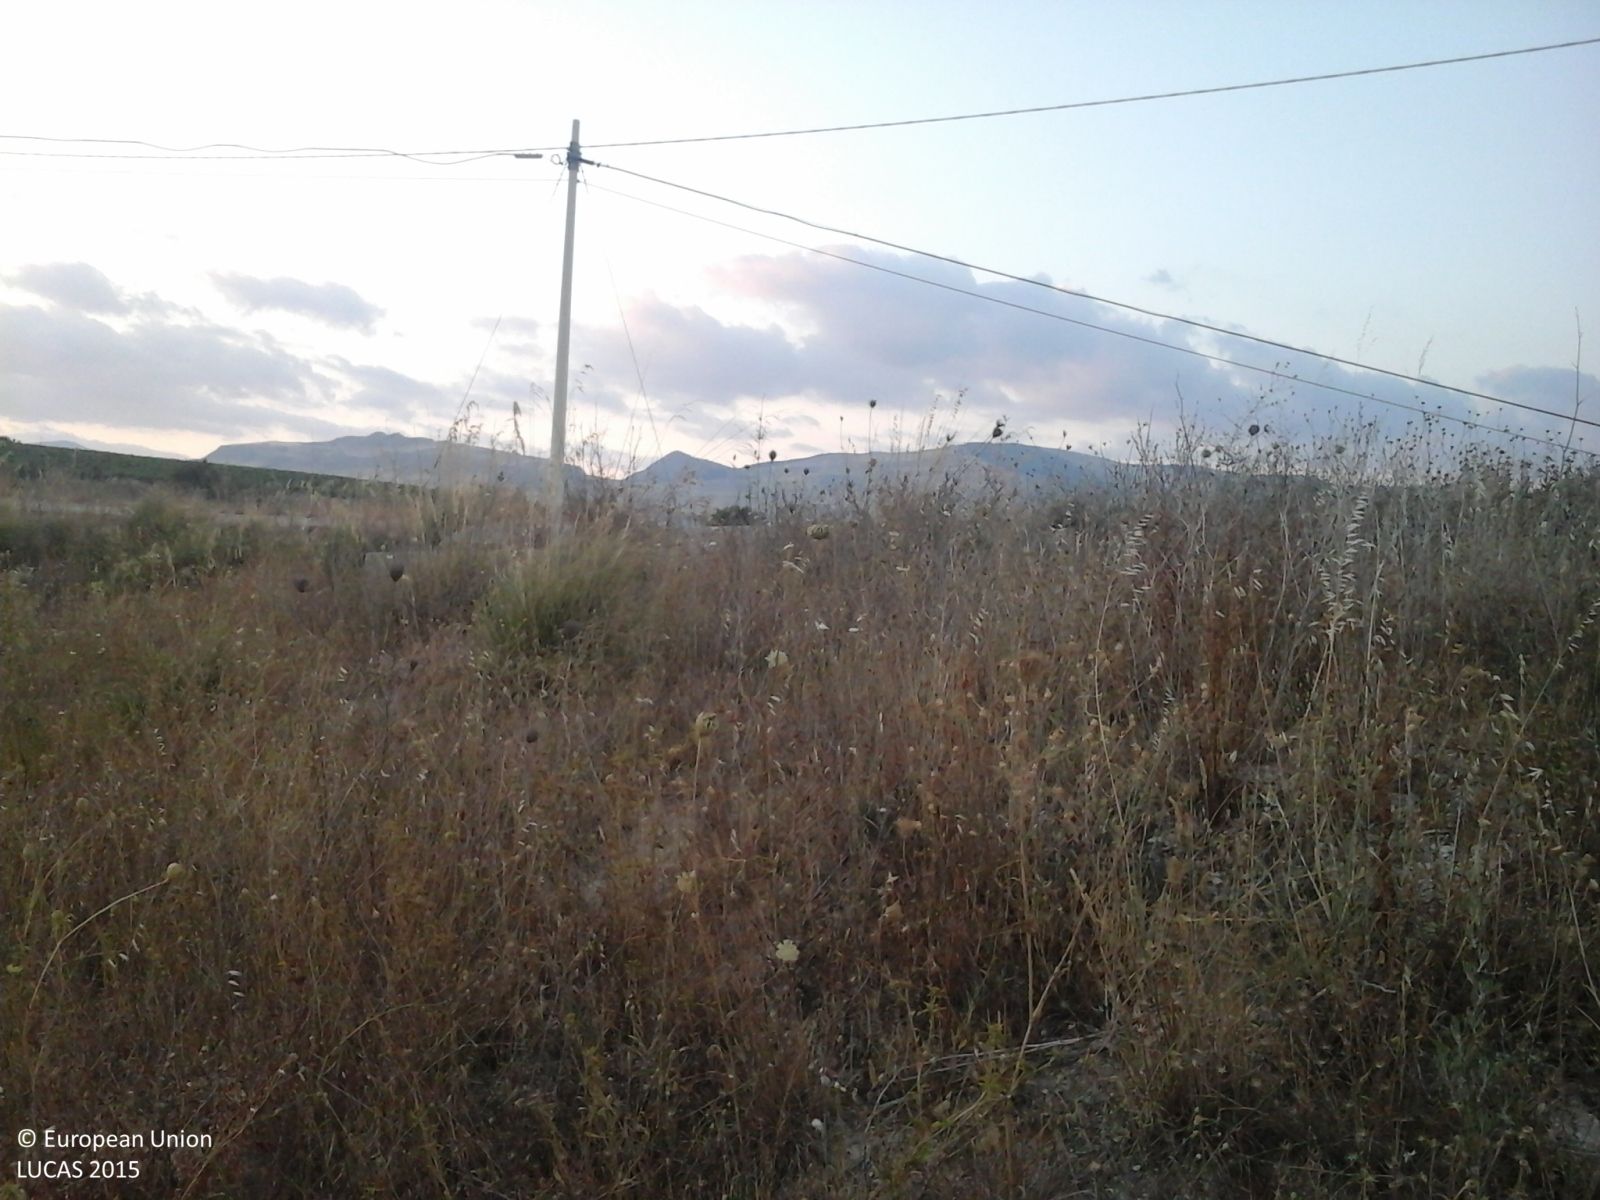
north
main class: Cropland
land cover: Durum wheat
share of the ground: > 75 %
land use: Agriculture (excluding fallow land and kitchen gardens)
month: July
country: IT
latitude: 37.5380
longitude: 13.4932
